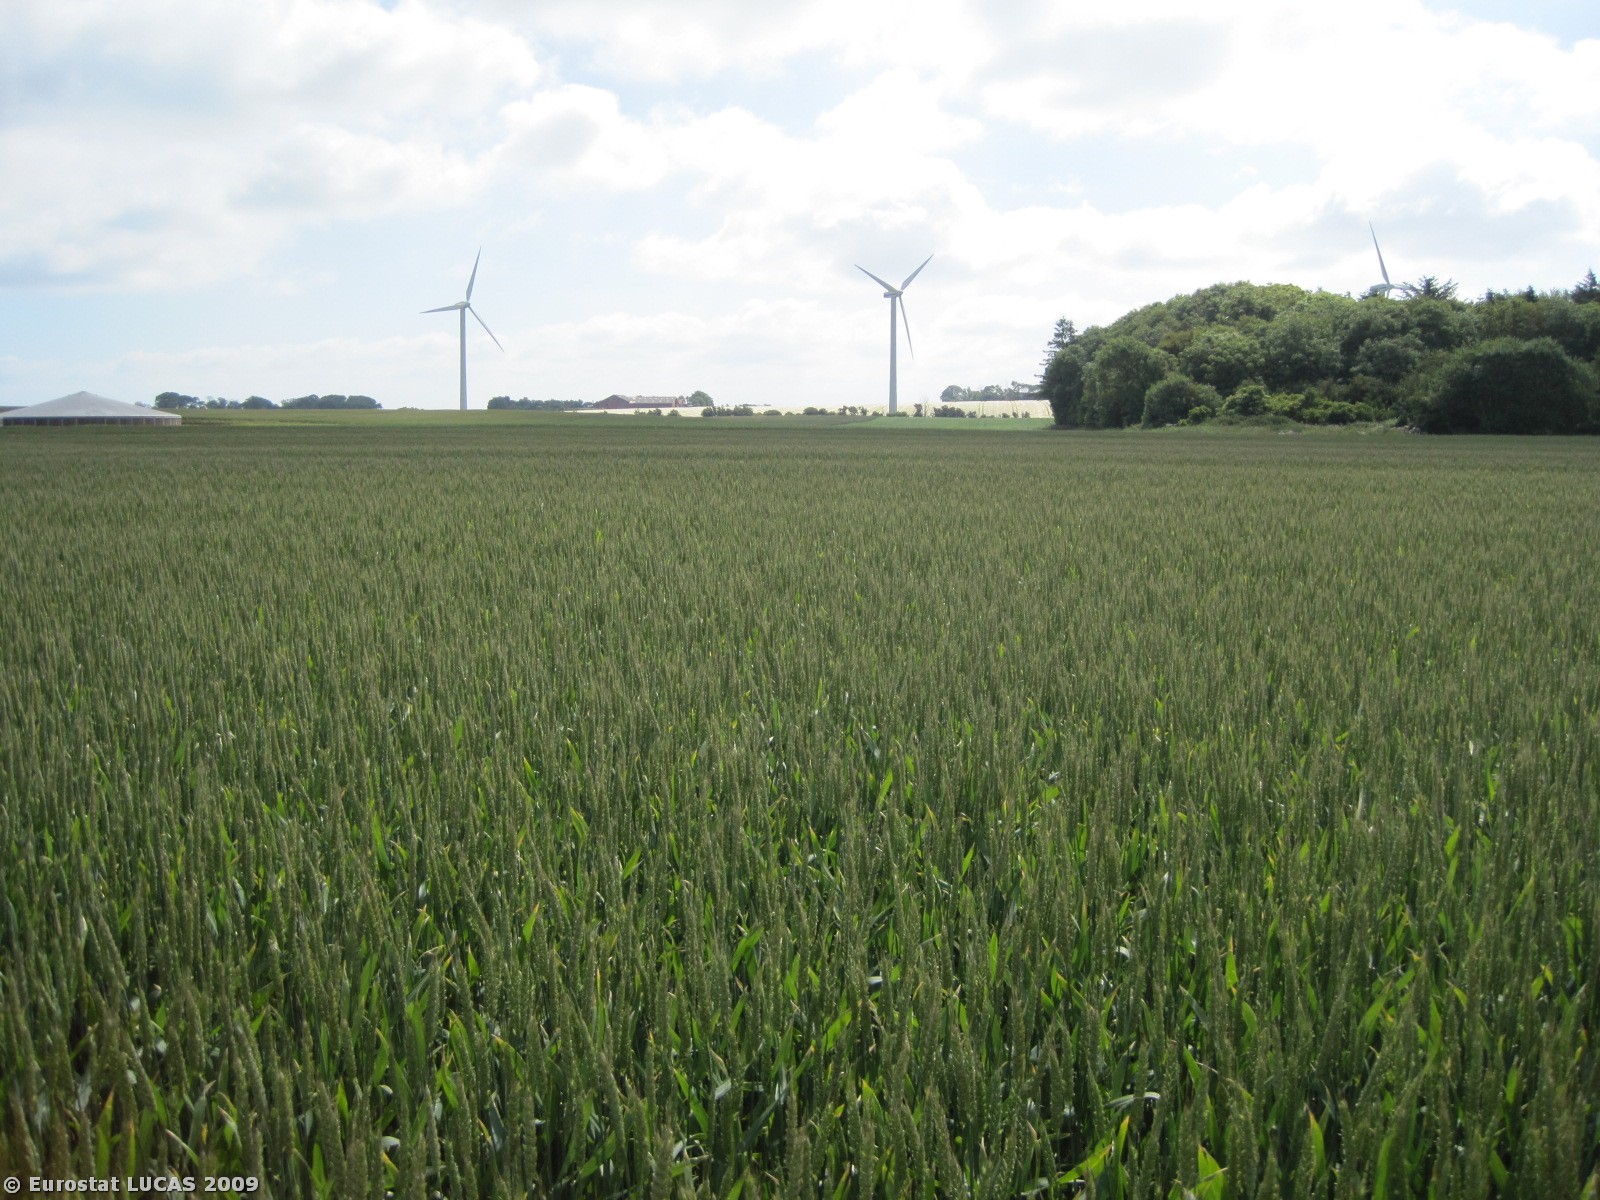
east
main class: Cropland
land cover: Common wheat
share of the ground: > 75 %
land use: Agriculture (excluding fallow land and kitchen gardens)
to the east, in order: Common wheat; Grass margins; Tracks; Grass margins; Barley
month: June
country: DK
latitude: 56.7749
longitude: 8.7417
